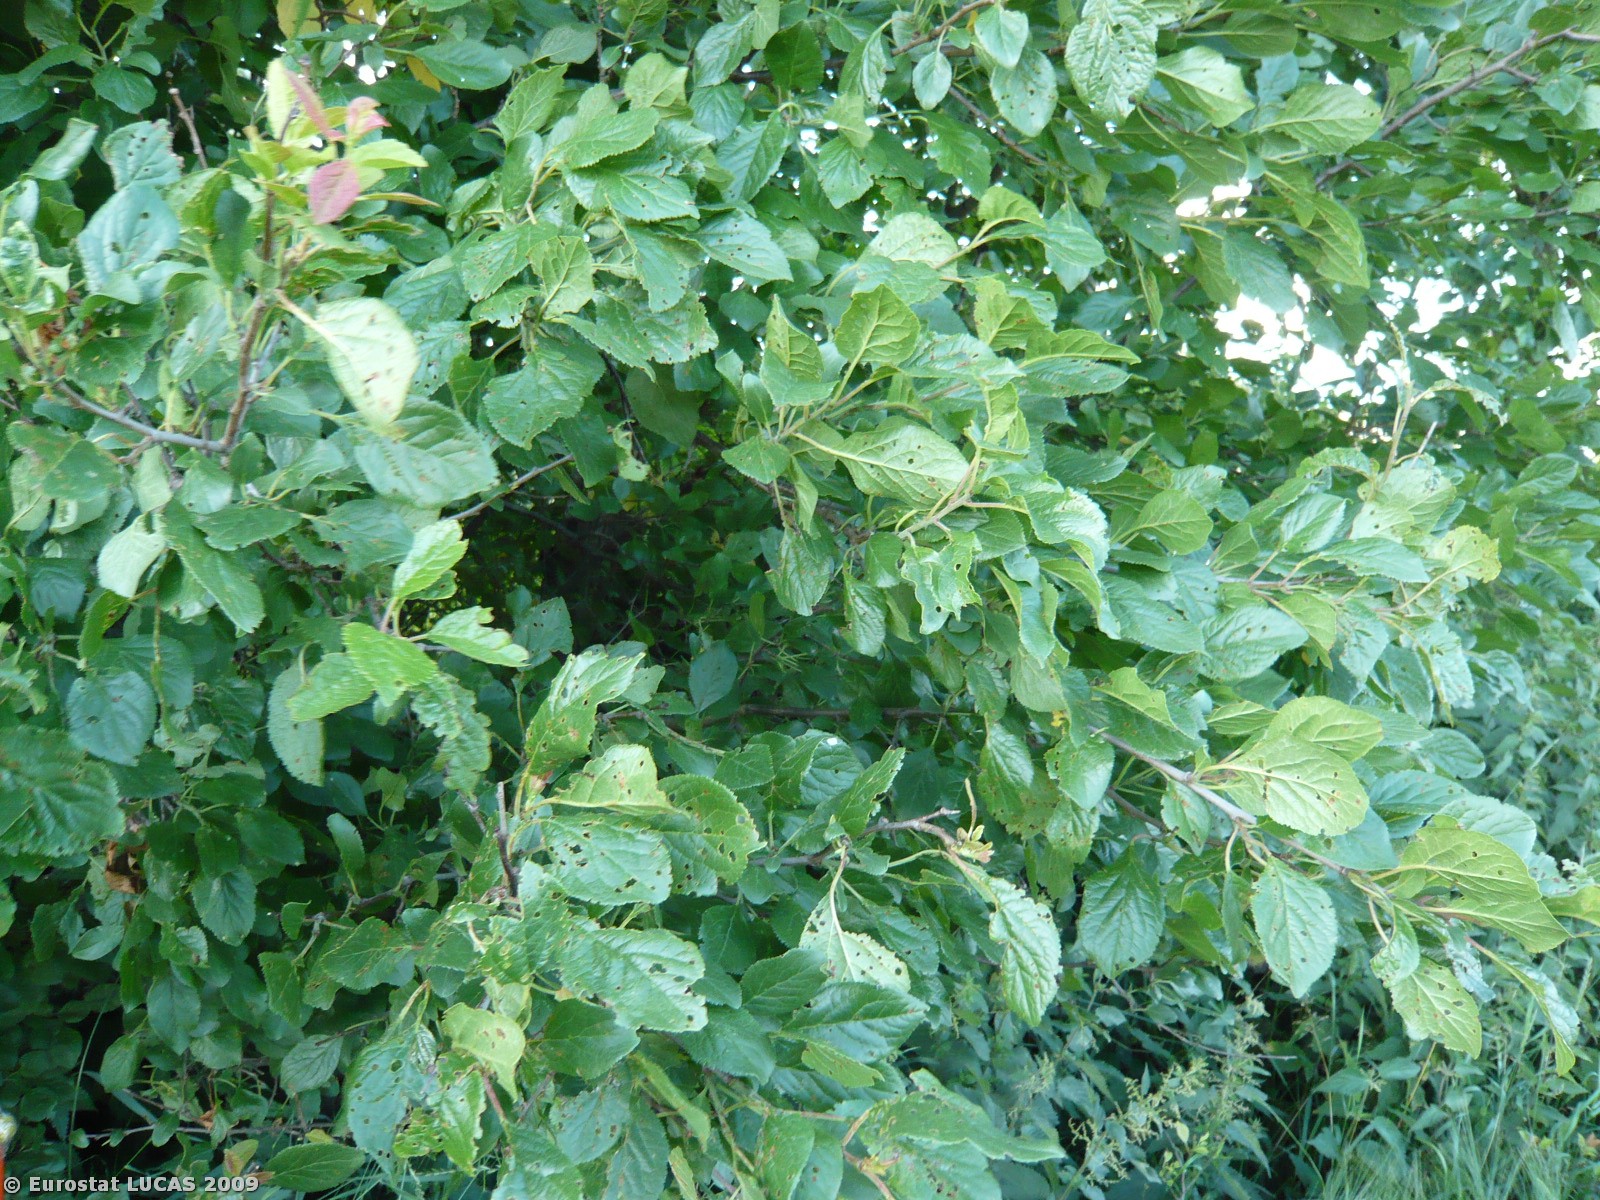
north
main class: Woodland
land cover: Broadleaved woodland
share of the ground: > 75 %
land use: Residential
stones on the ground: < 10 %
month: July
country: DK
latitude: 55.5691
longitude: 11.3784
